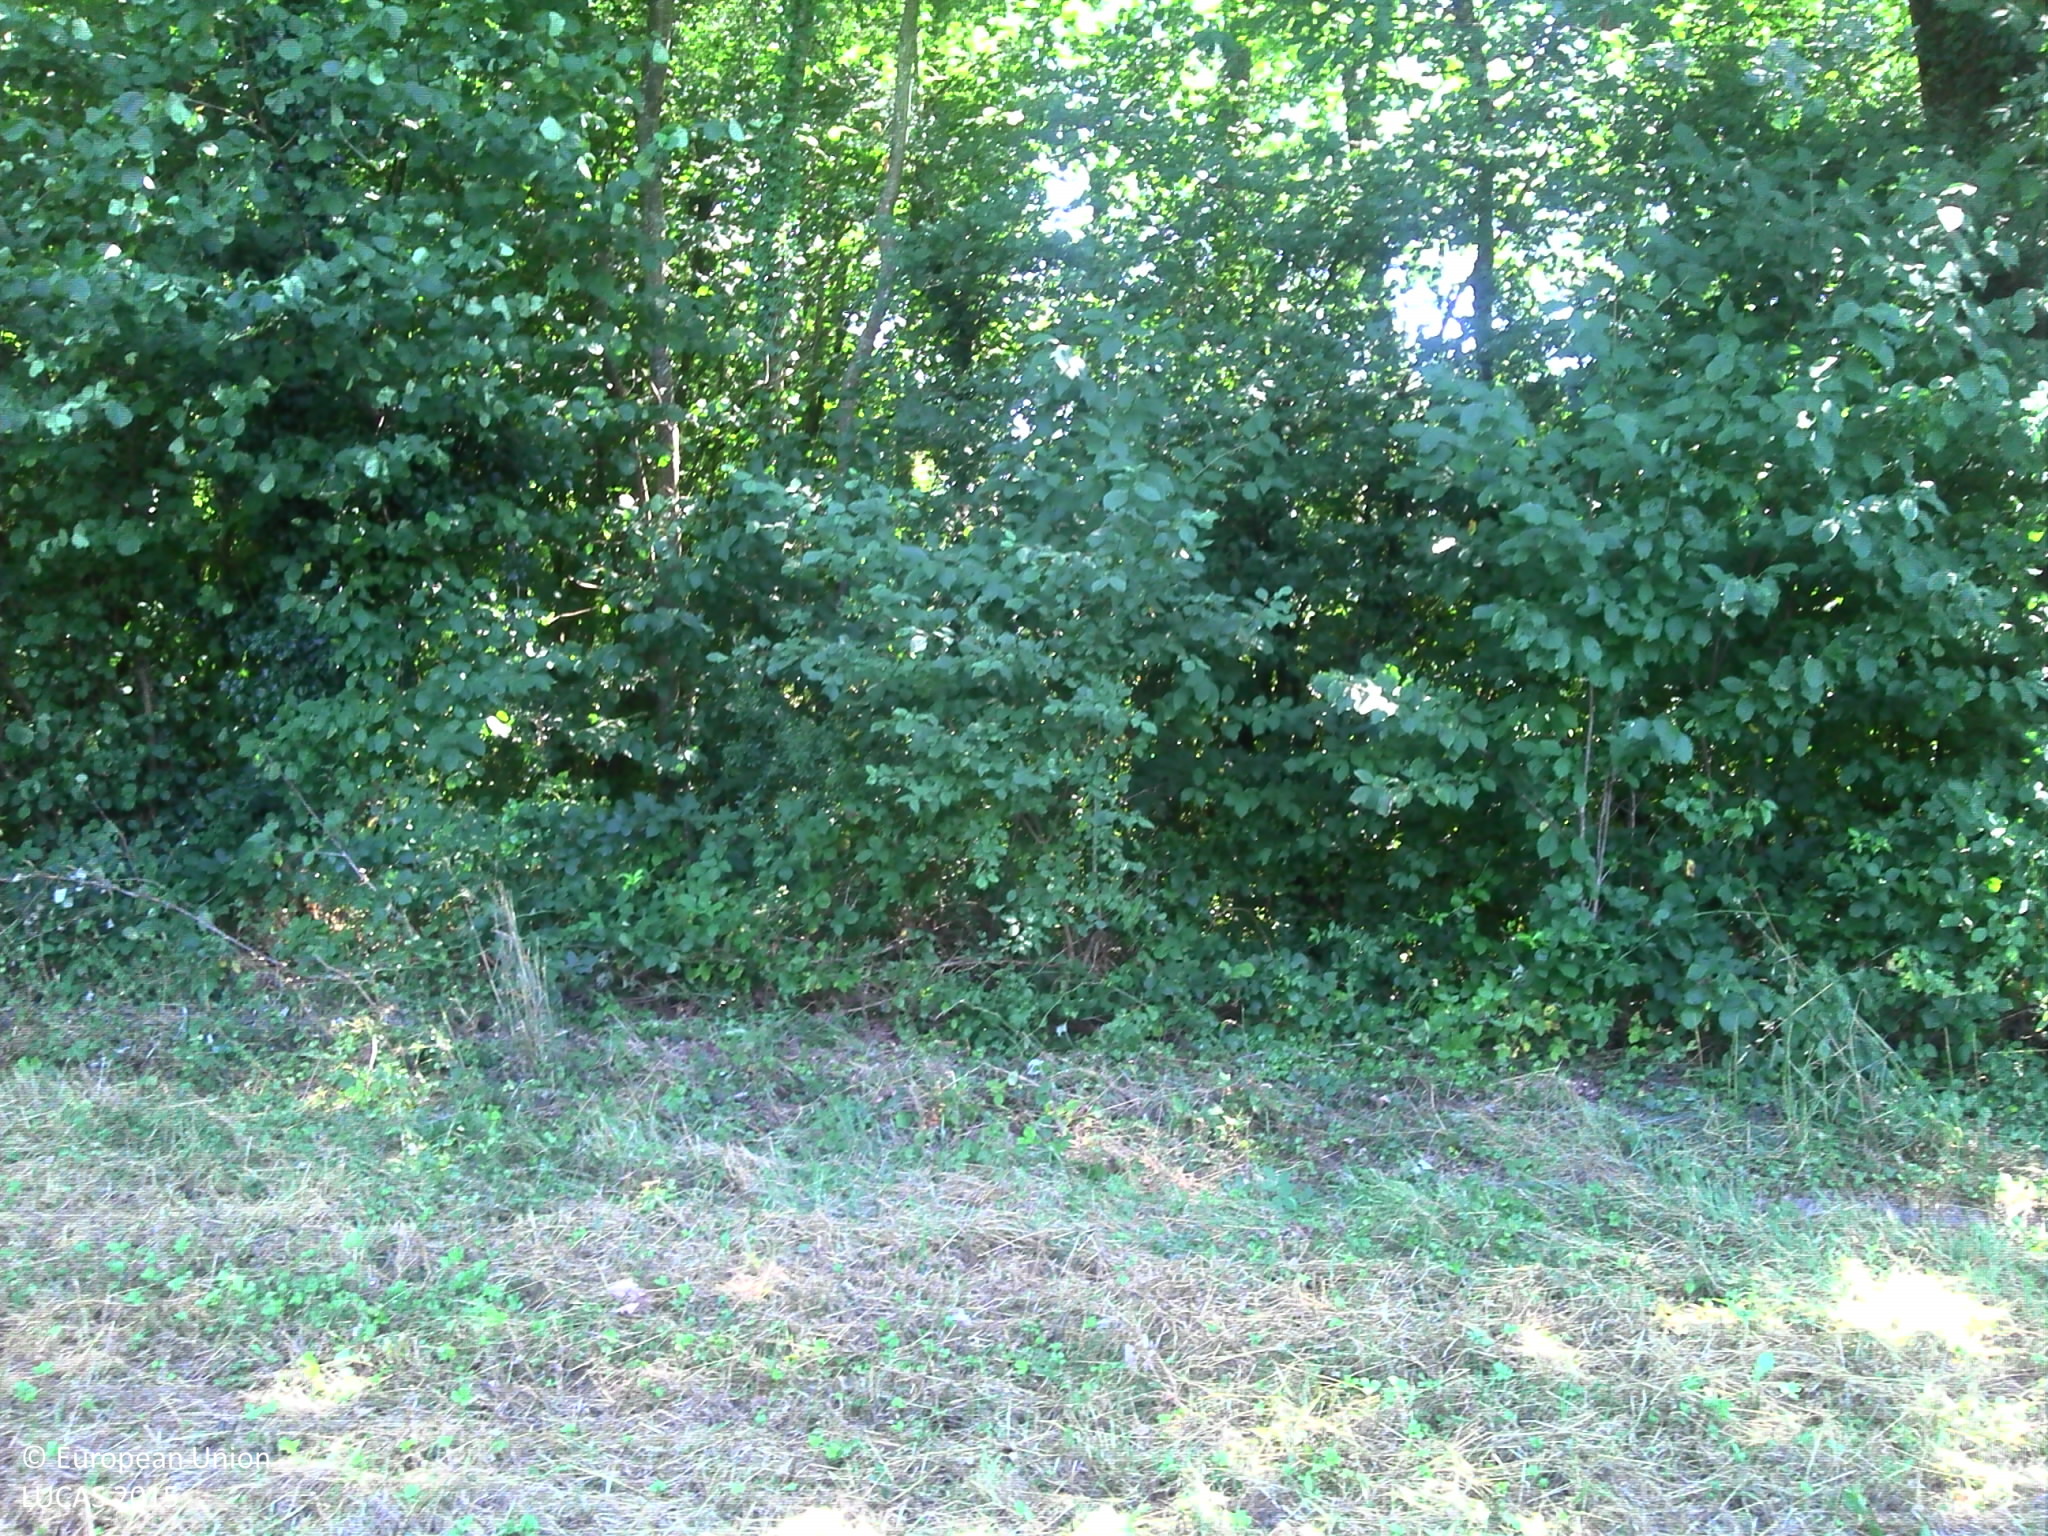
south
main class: Cropland
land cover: Maize
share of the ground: > 75 %
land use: Agriculture (excluding fallow land and kitchen gardens)
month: July
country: FR
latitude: 45.6410
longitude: 5.4498
